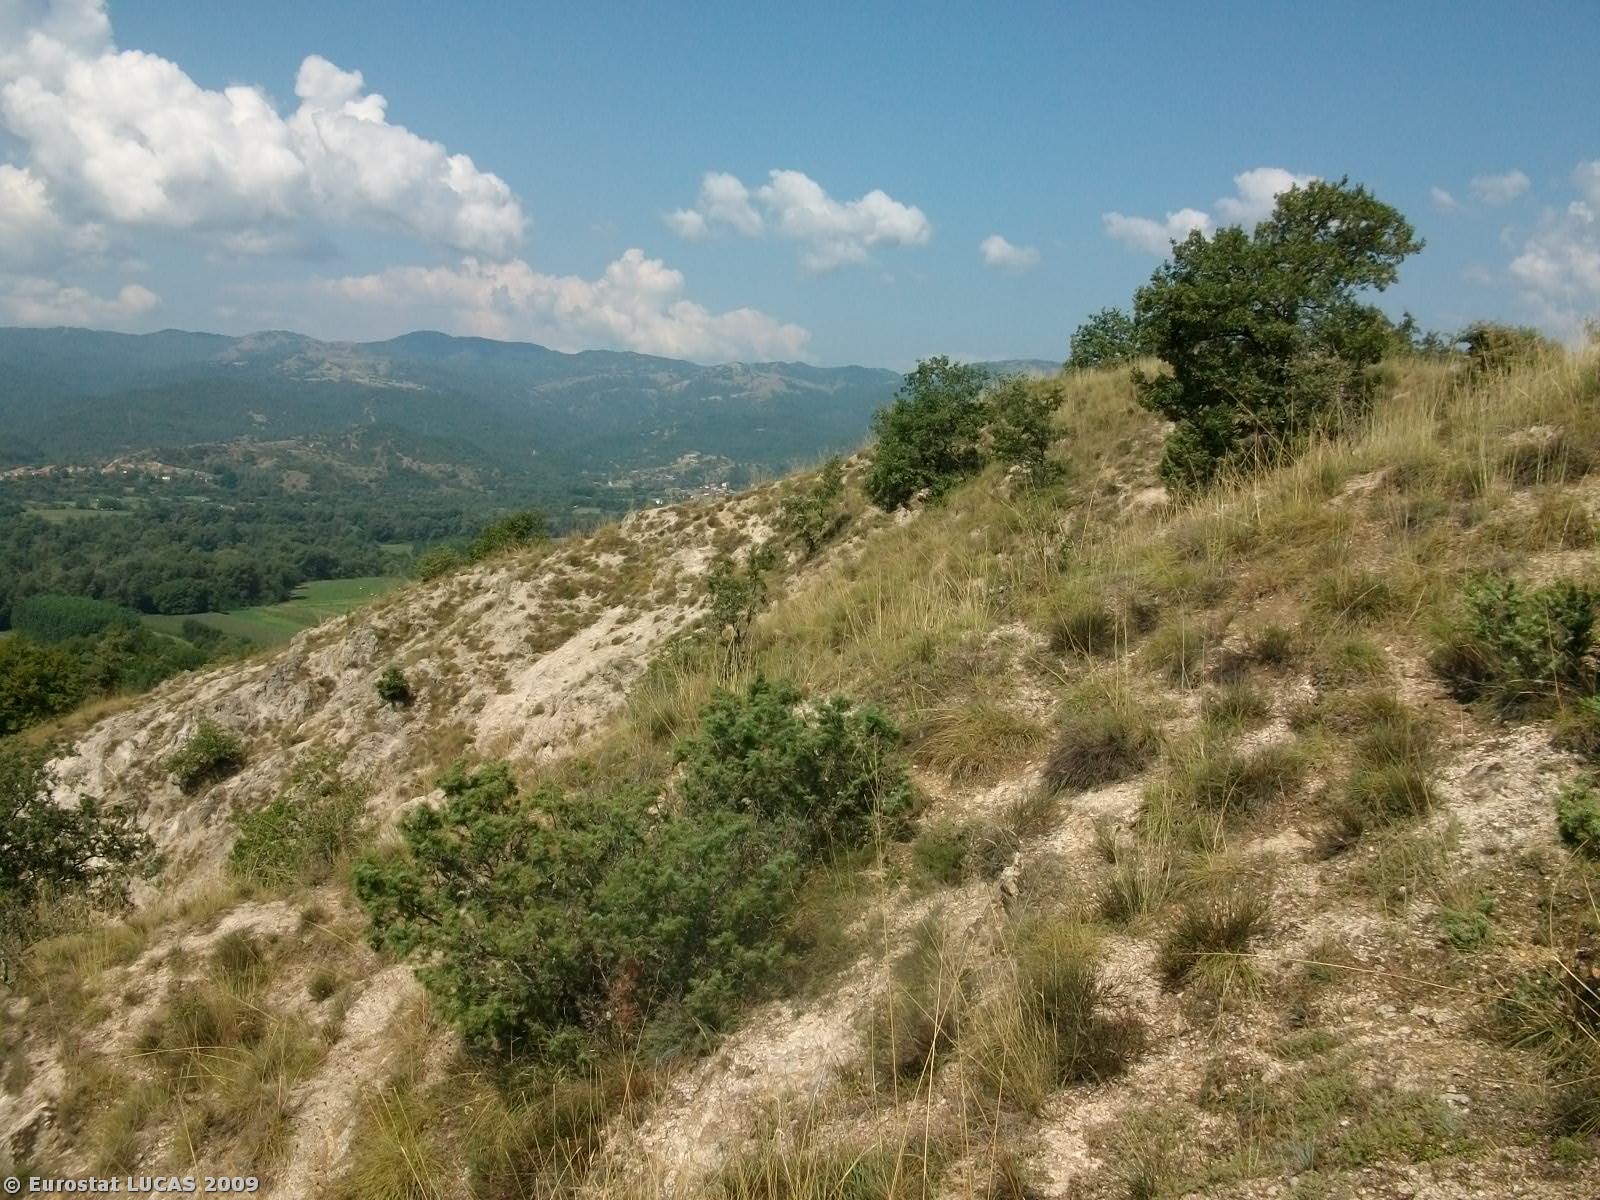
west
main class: Shrubland
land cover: Shrubland with sparse tree cover
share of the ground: > 75 %
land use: Unused
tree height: < 5 m
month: August
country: GR
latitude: 41.2754
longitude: 24.4938
